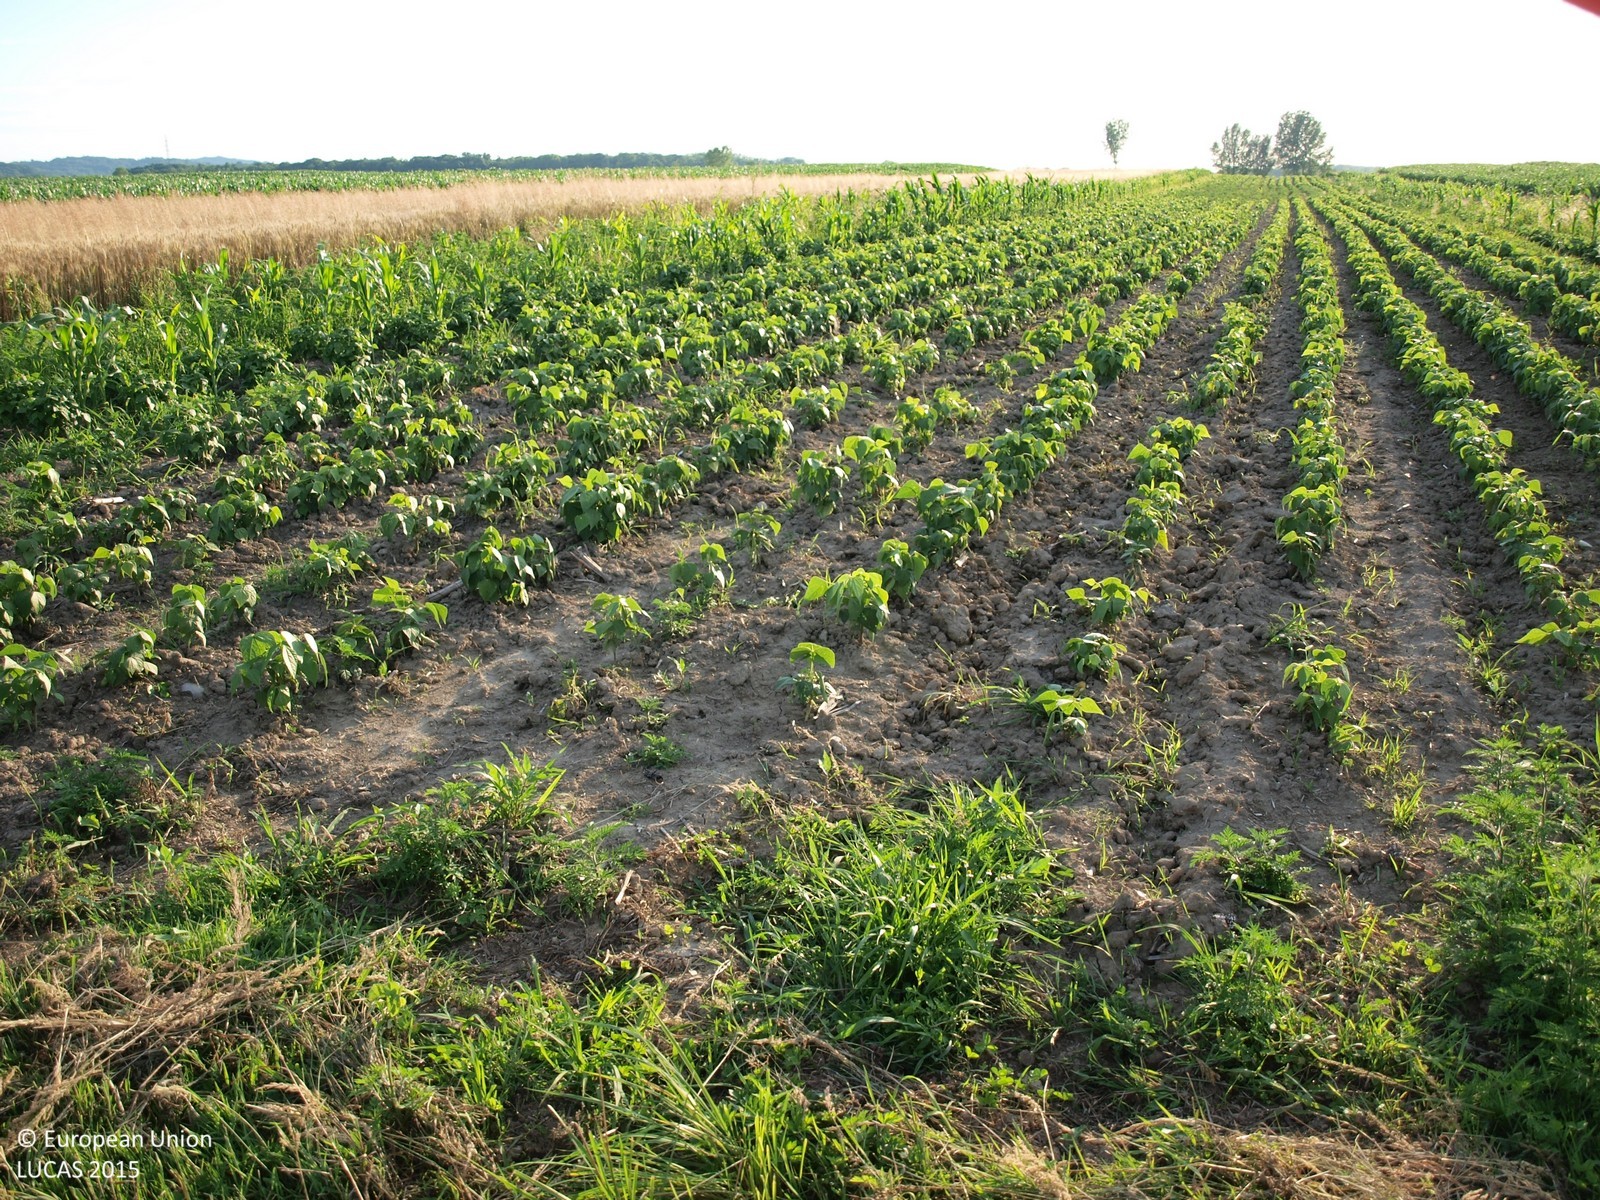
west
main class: Grassland
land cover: Grassland without tree/shrub cover
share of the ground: > 75 %
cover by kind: herbaceous plants 100 %
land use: Agriculture (excluding fallow land and kitchen gardens)
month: June
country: HR
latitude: 46.2523
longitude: 16.6553
